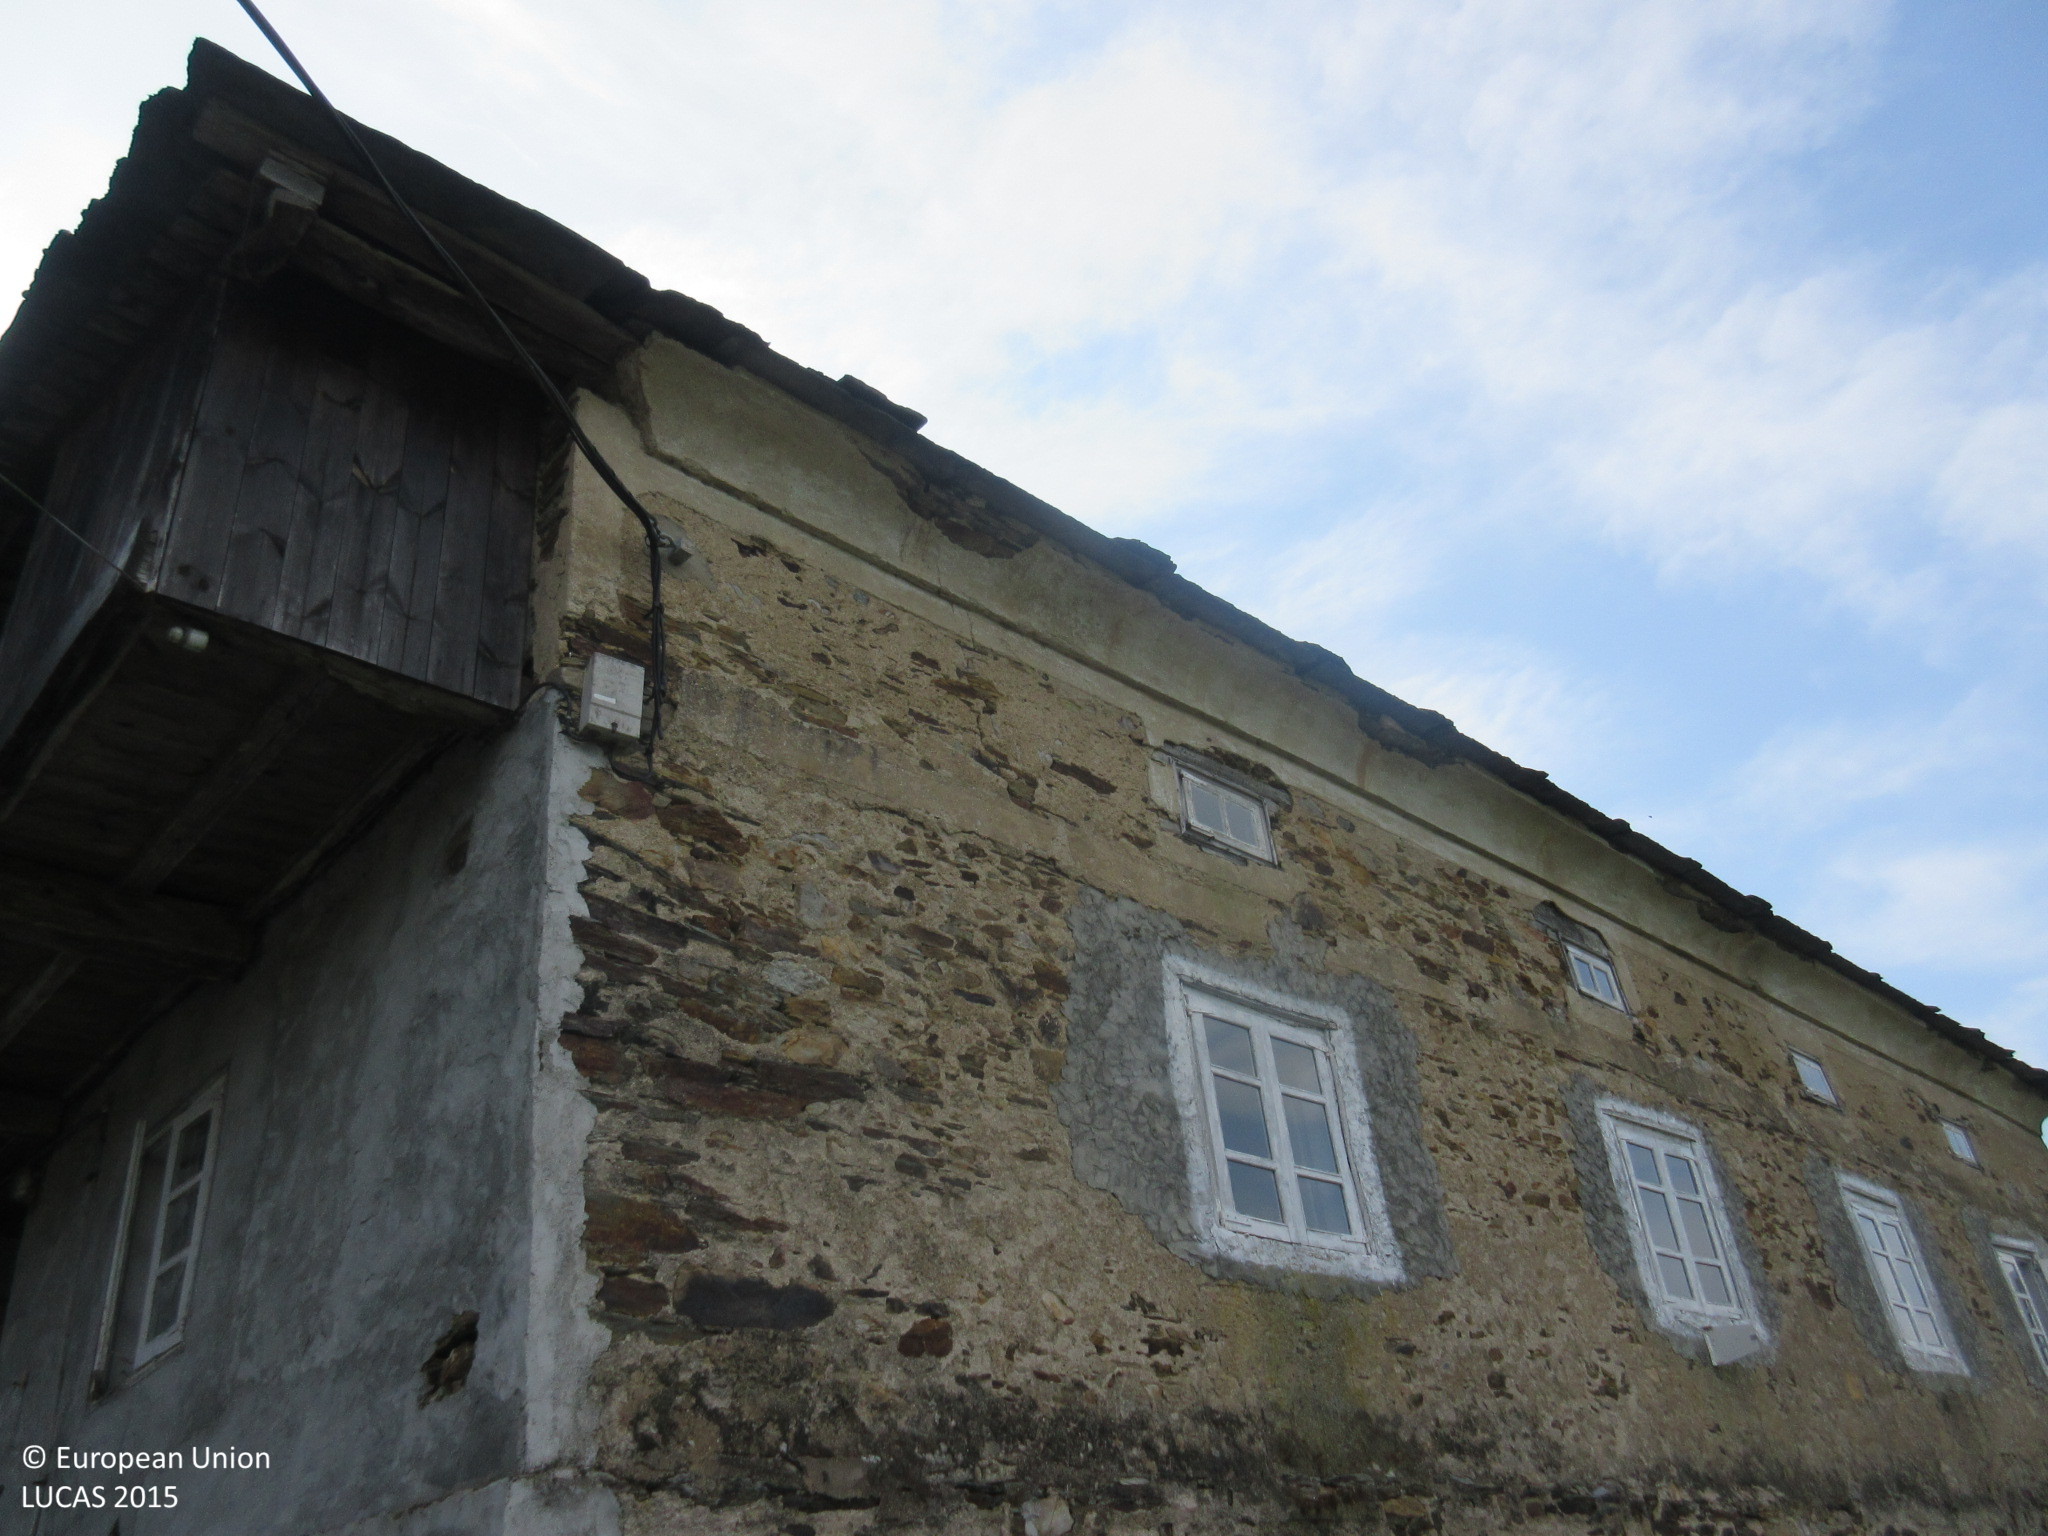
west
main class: Cropland
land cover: Potatoes
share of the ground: > 75 %
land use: Kitchen garden
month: April
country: ES
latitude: 43.4530
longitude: -6.9850
